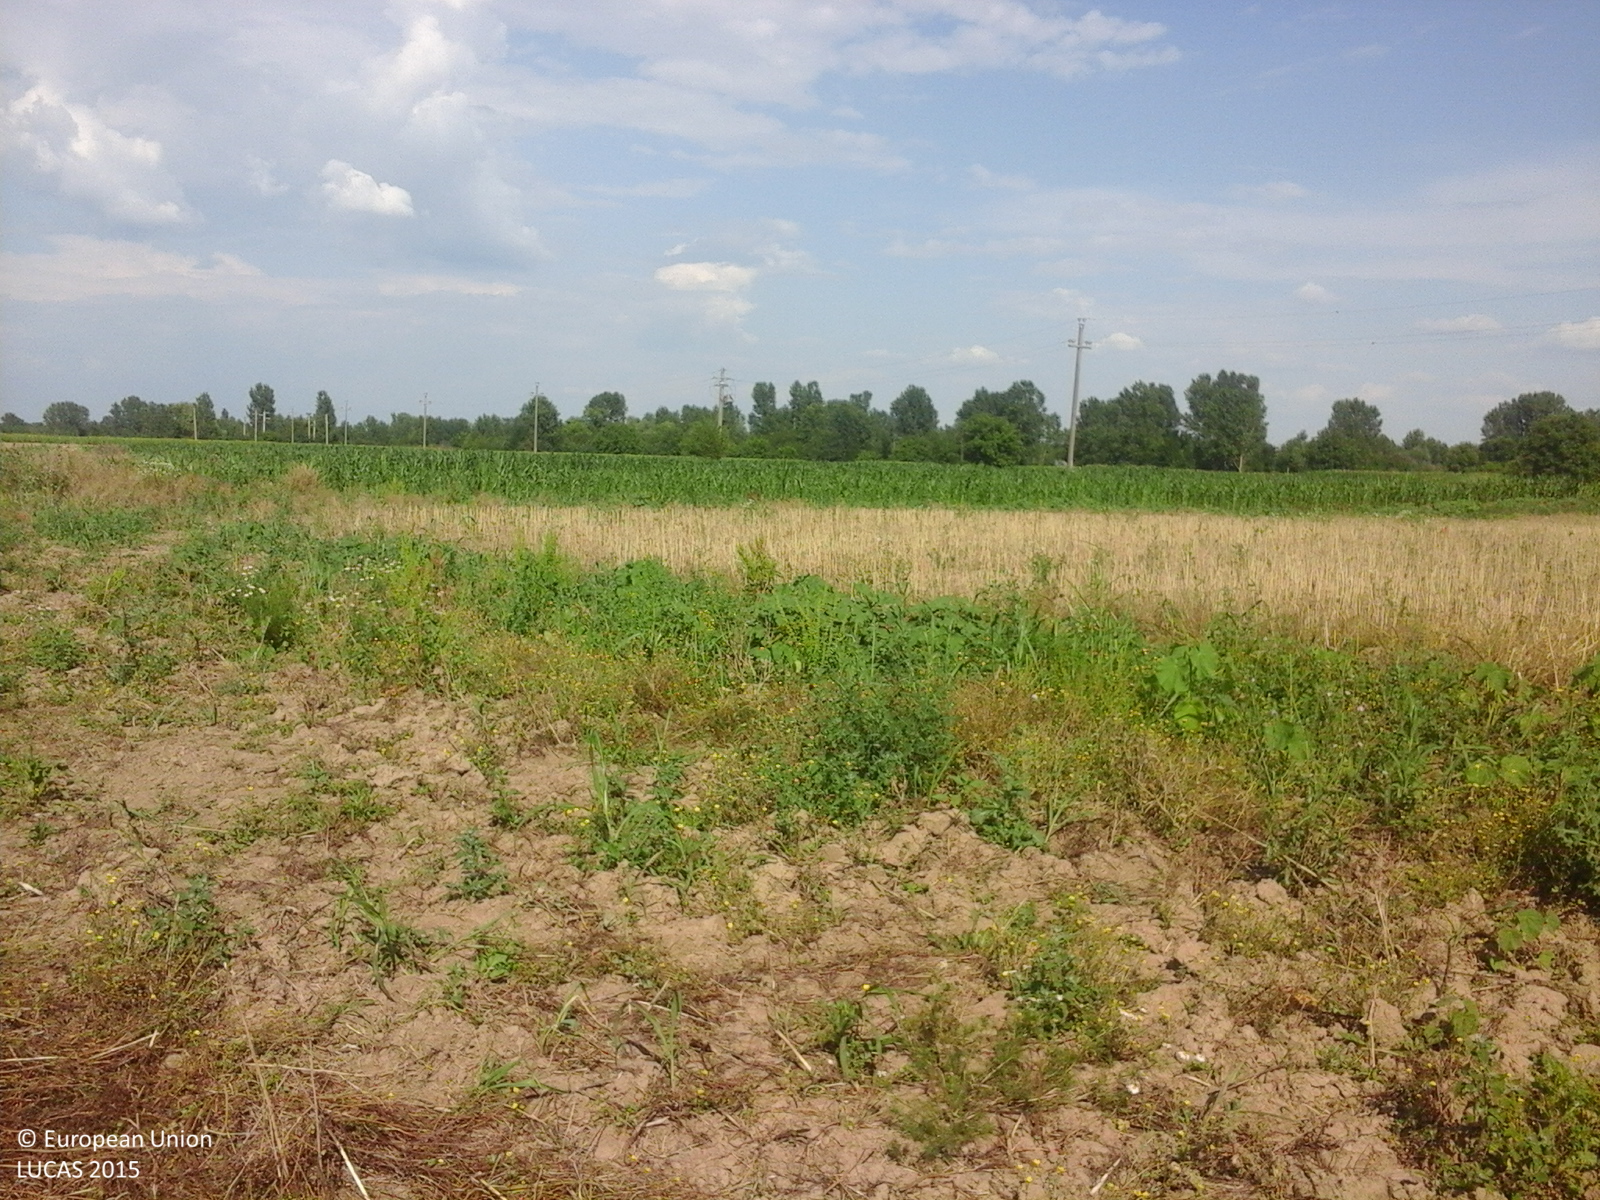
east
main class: Grassland
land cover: Spontaneously vegetated surfaces
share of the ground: > 75 %
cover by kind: herbaceous plants 100 %
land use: Fallow land
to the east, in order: Spontaneously vegetated surfaces; Rape and turnip rape; Maize; Electric lines; Maize; Common wheat; Lucerne; Common wheat
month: July
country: RO
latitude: 44.0014
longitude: 26.1011
